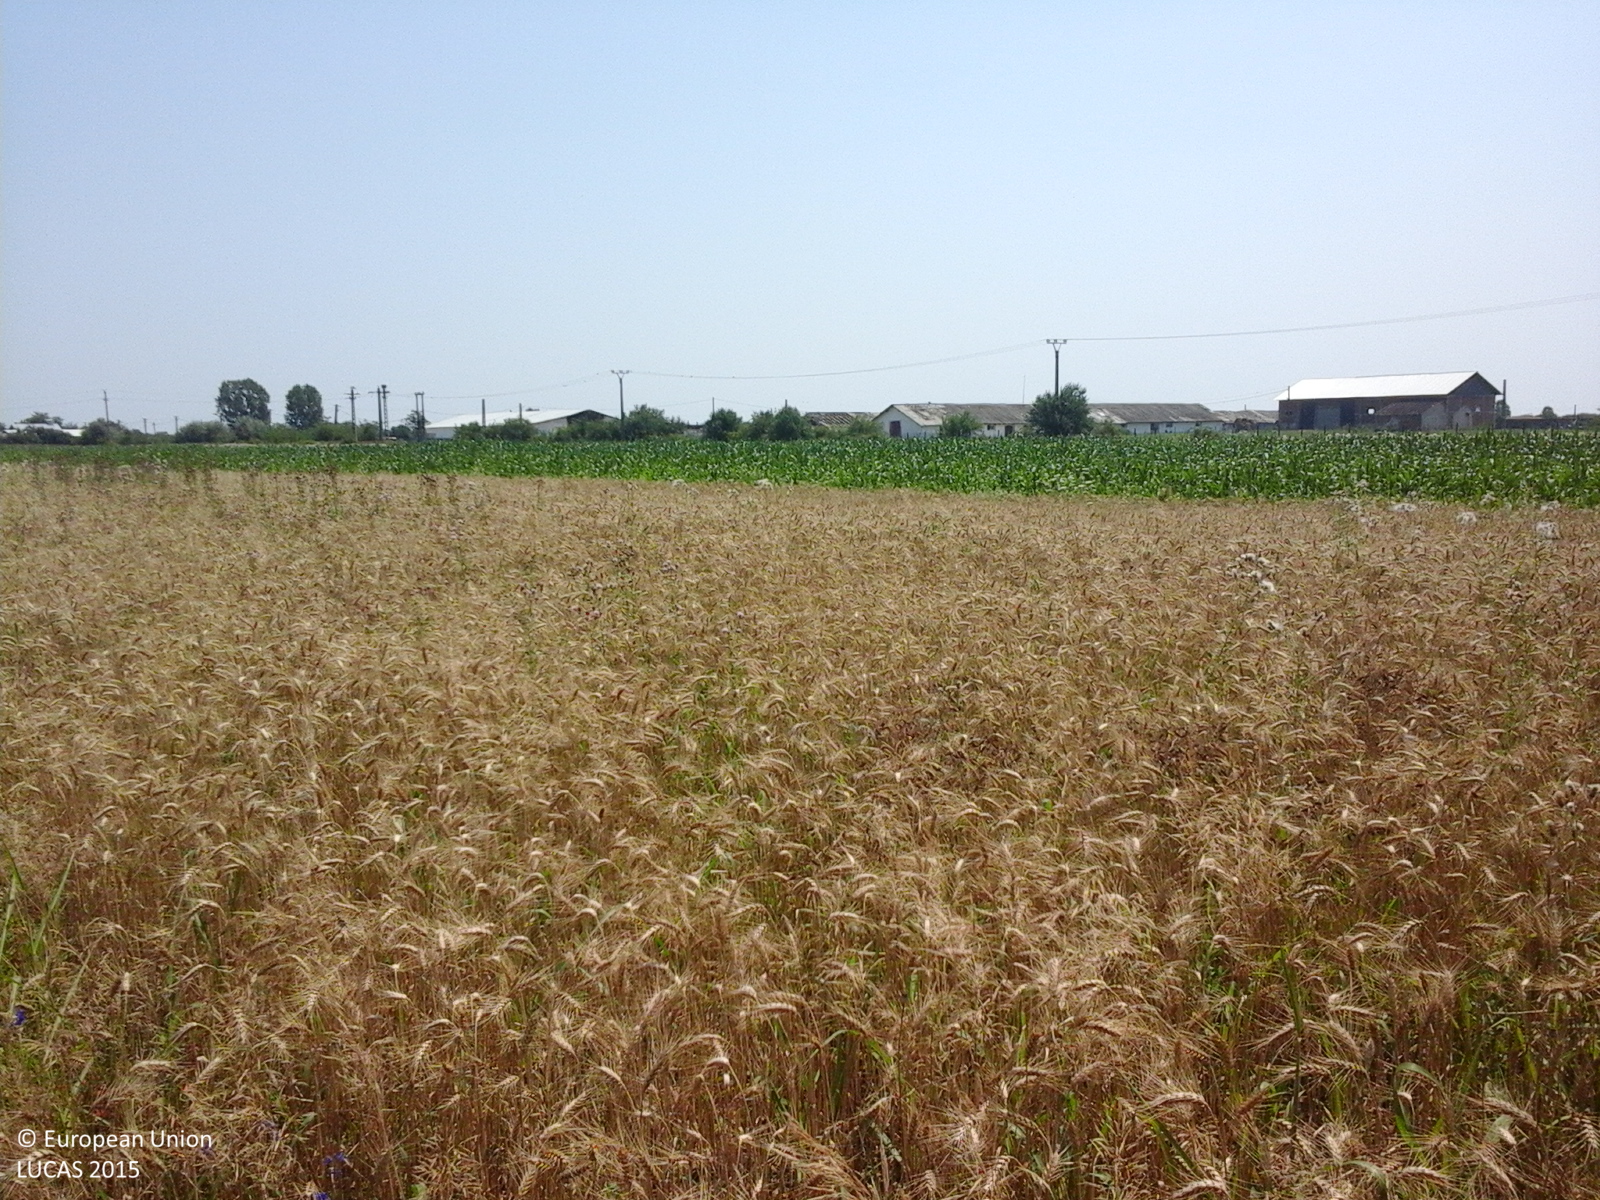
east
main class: Cropland
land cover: Common wheat
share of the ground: > 75 %
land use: Agriculture (excluding fallow land and kitchen gardens)
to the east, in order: Common wheat; Maize; Common wheat; Grassland without tree/shrub cover; Electric lines; Abandoned hedges; Ditches and canals; Grass margins; Paved roads, cycling and walking lanes; Grass margins; Artificial constructions in urban areas
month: July
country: RO
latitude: 44.7783
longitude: 25.7061
